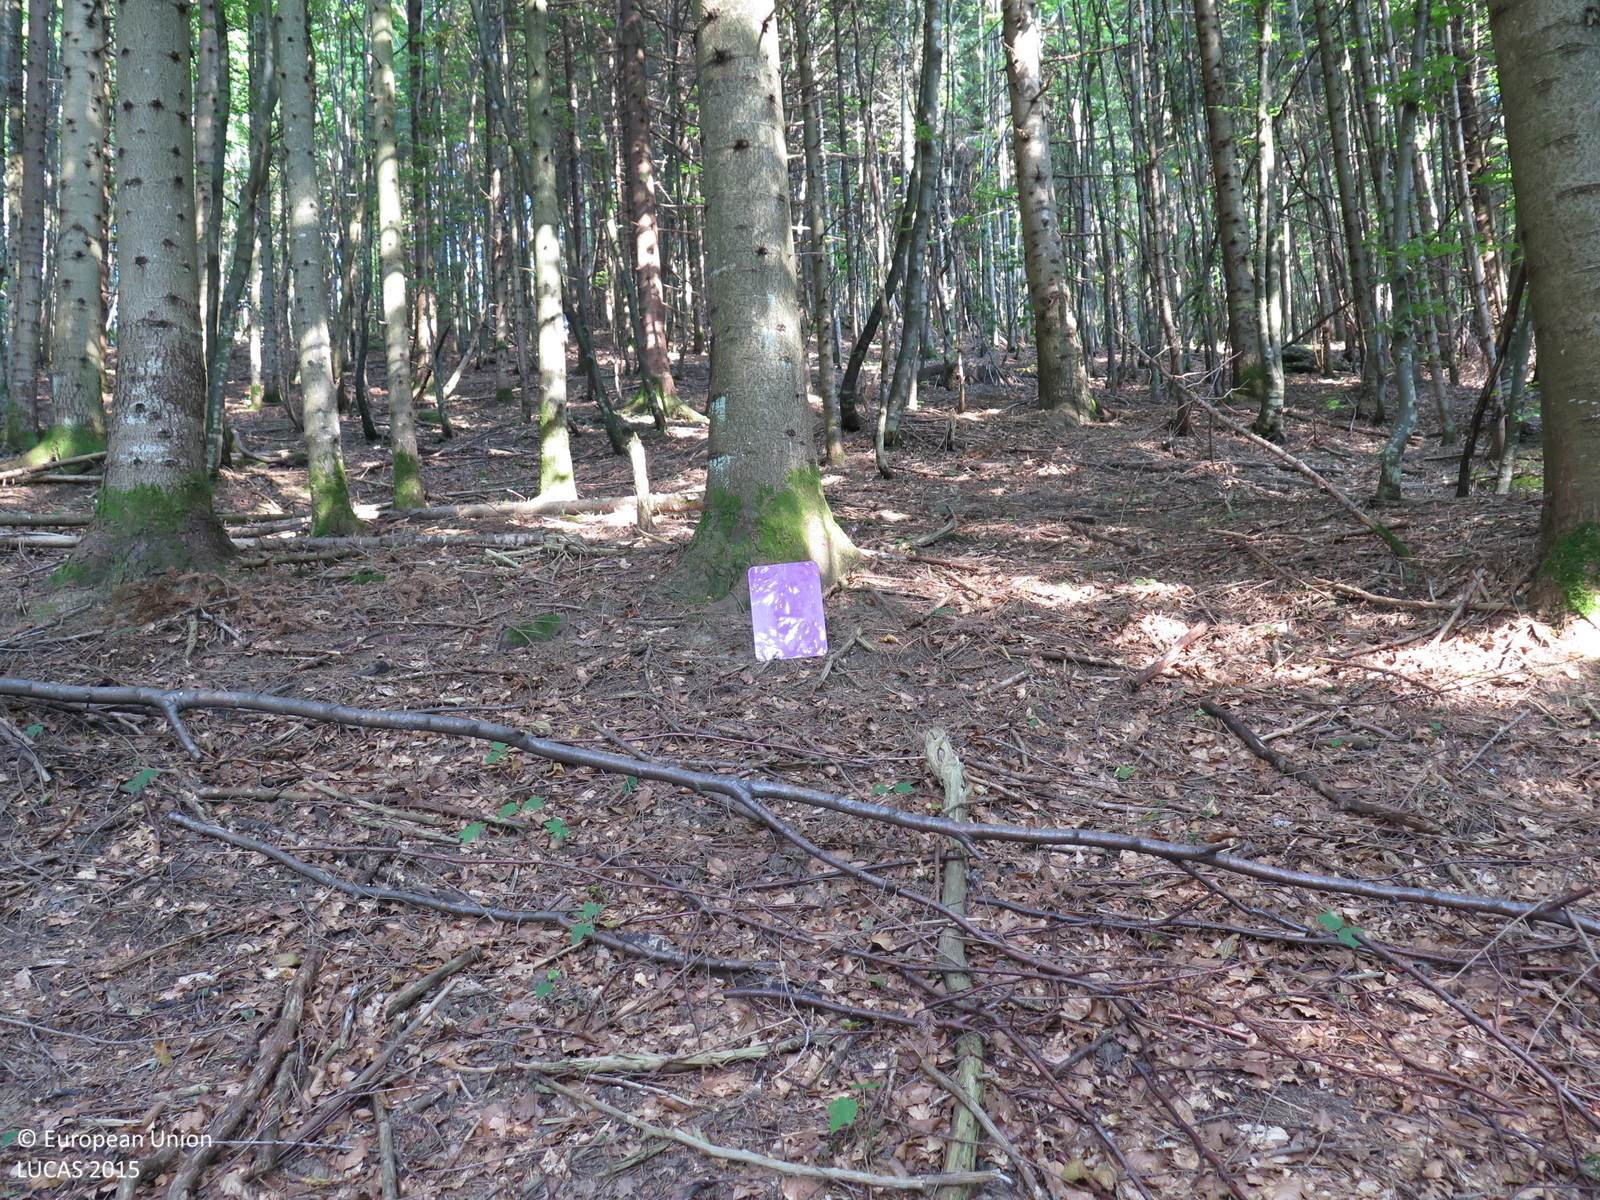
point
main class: Woodland
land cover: Other mixed woodland
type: beech forest
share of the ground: > 75 %
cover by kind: coniferous forest trees 75 %, broadleaved forest trees 25 %
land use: Forestry
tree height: > 5 m
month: August
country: HR
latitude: 45.3469
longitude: 15.0623
